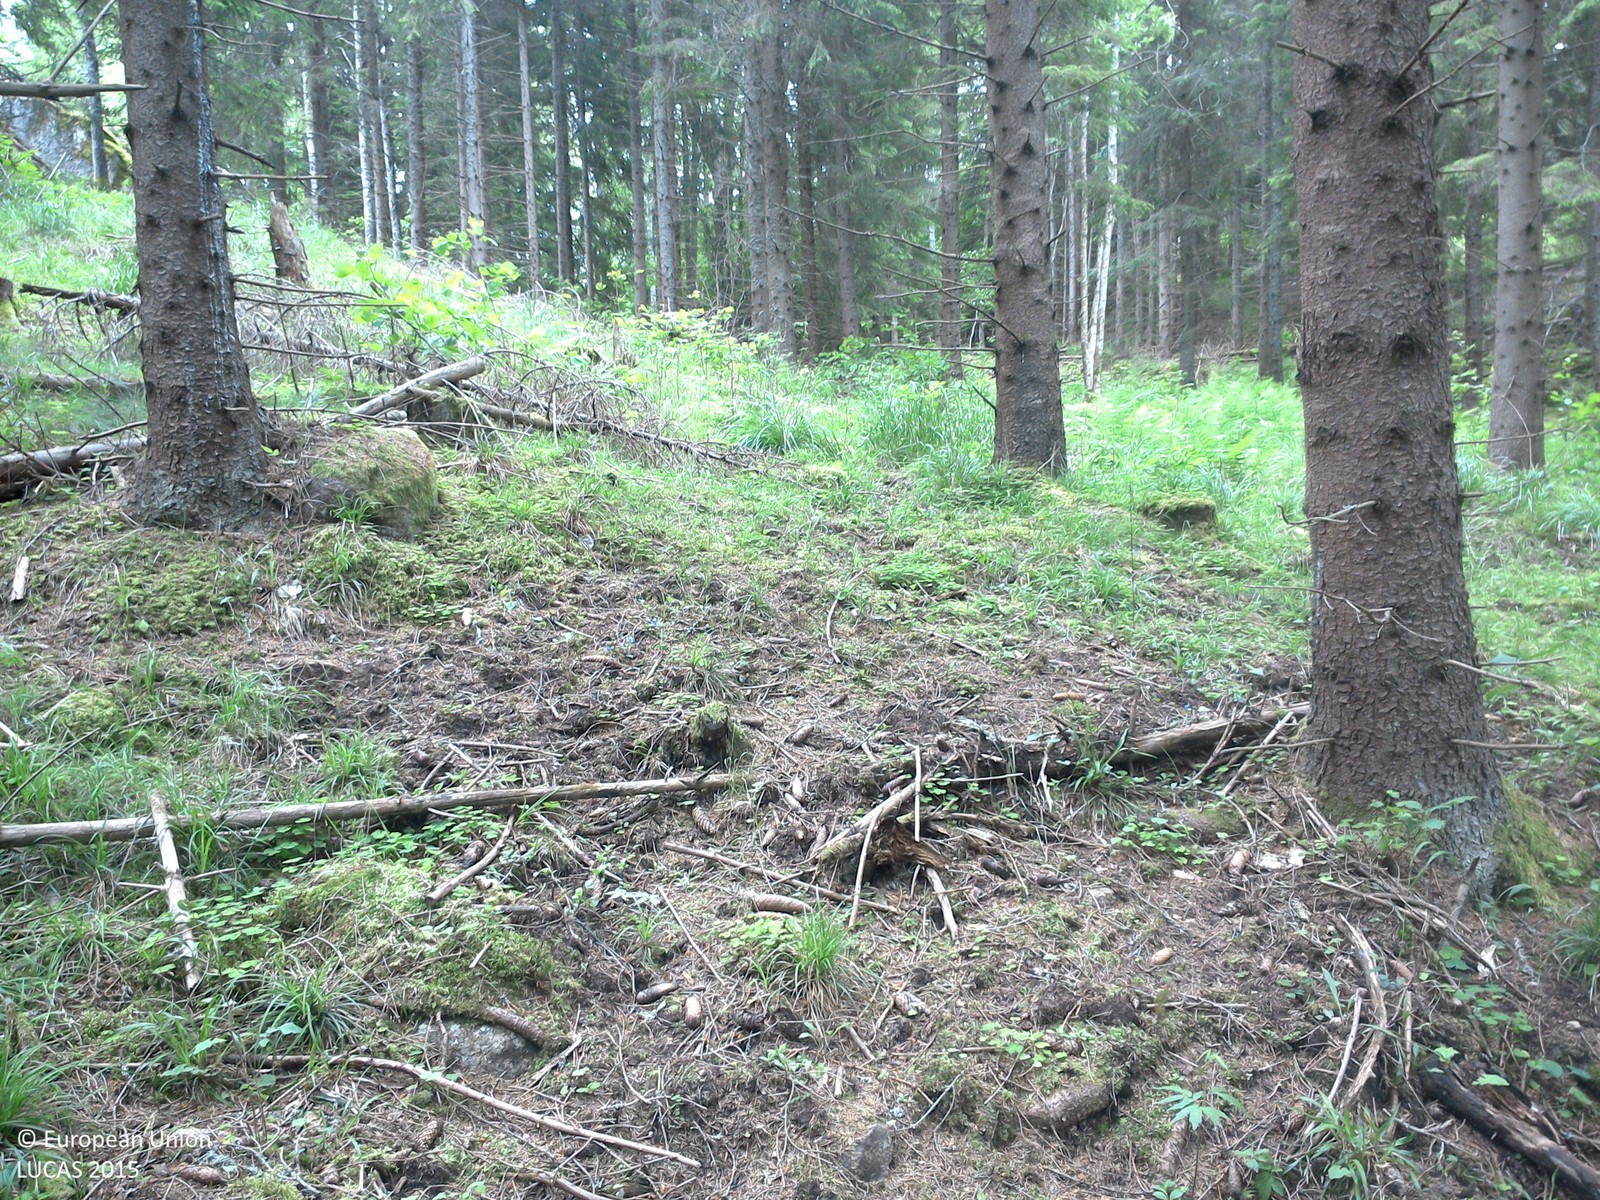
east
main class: Woodland
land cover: Spruce dominated coniferous woodland
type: boreal forest
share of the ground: 50 - 75 %
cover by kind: coniferous forest trees 60 %, lichens and mosses 40 %
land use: Forestry
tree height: > 5 m
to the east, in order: Spruce dominated coniferous woodland; Spruce dominated mixed woodland; Spruce dominated coniferous woodland
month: June
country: SE
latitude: 58.0914
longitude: 15.4402
